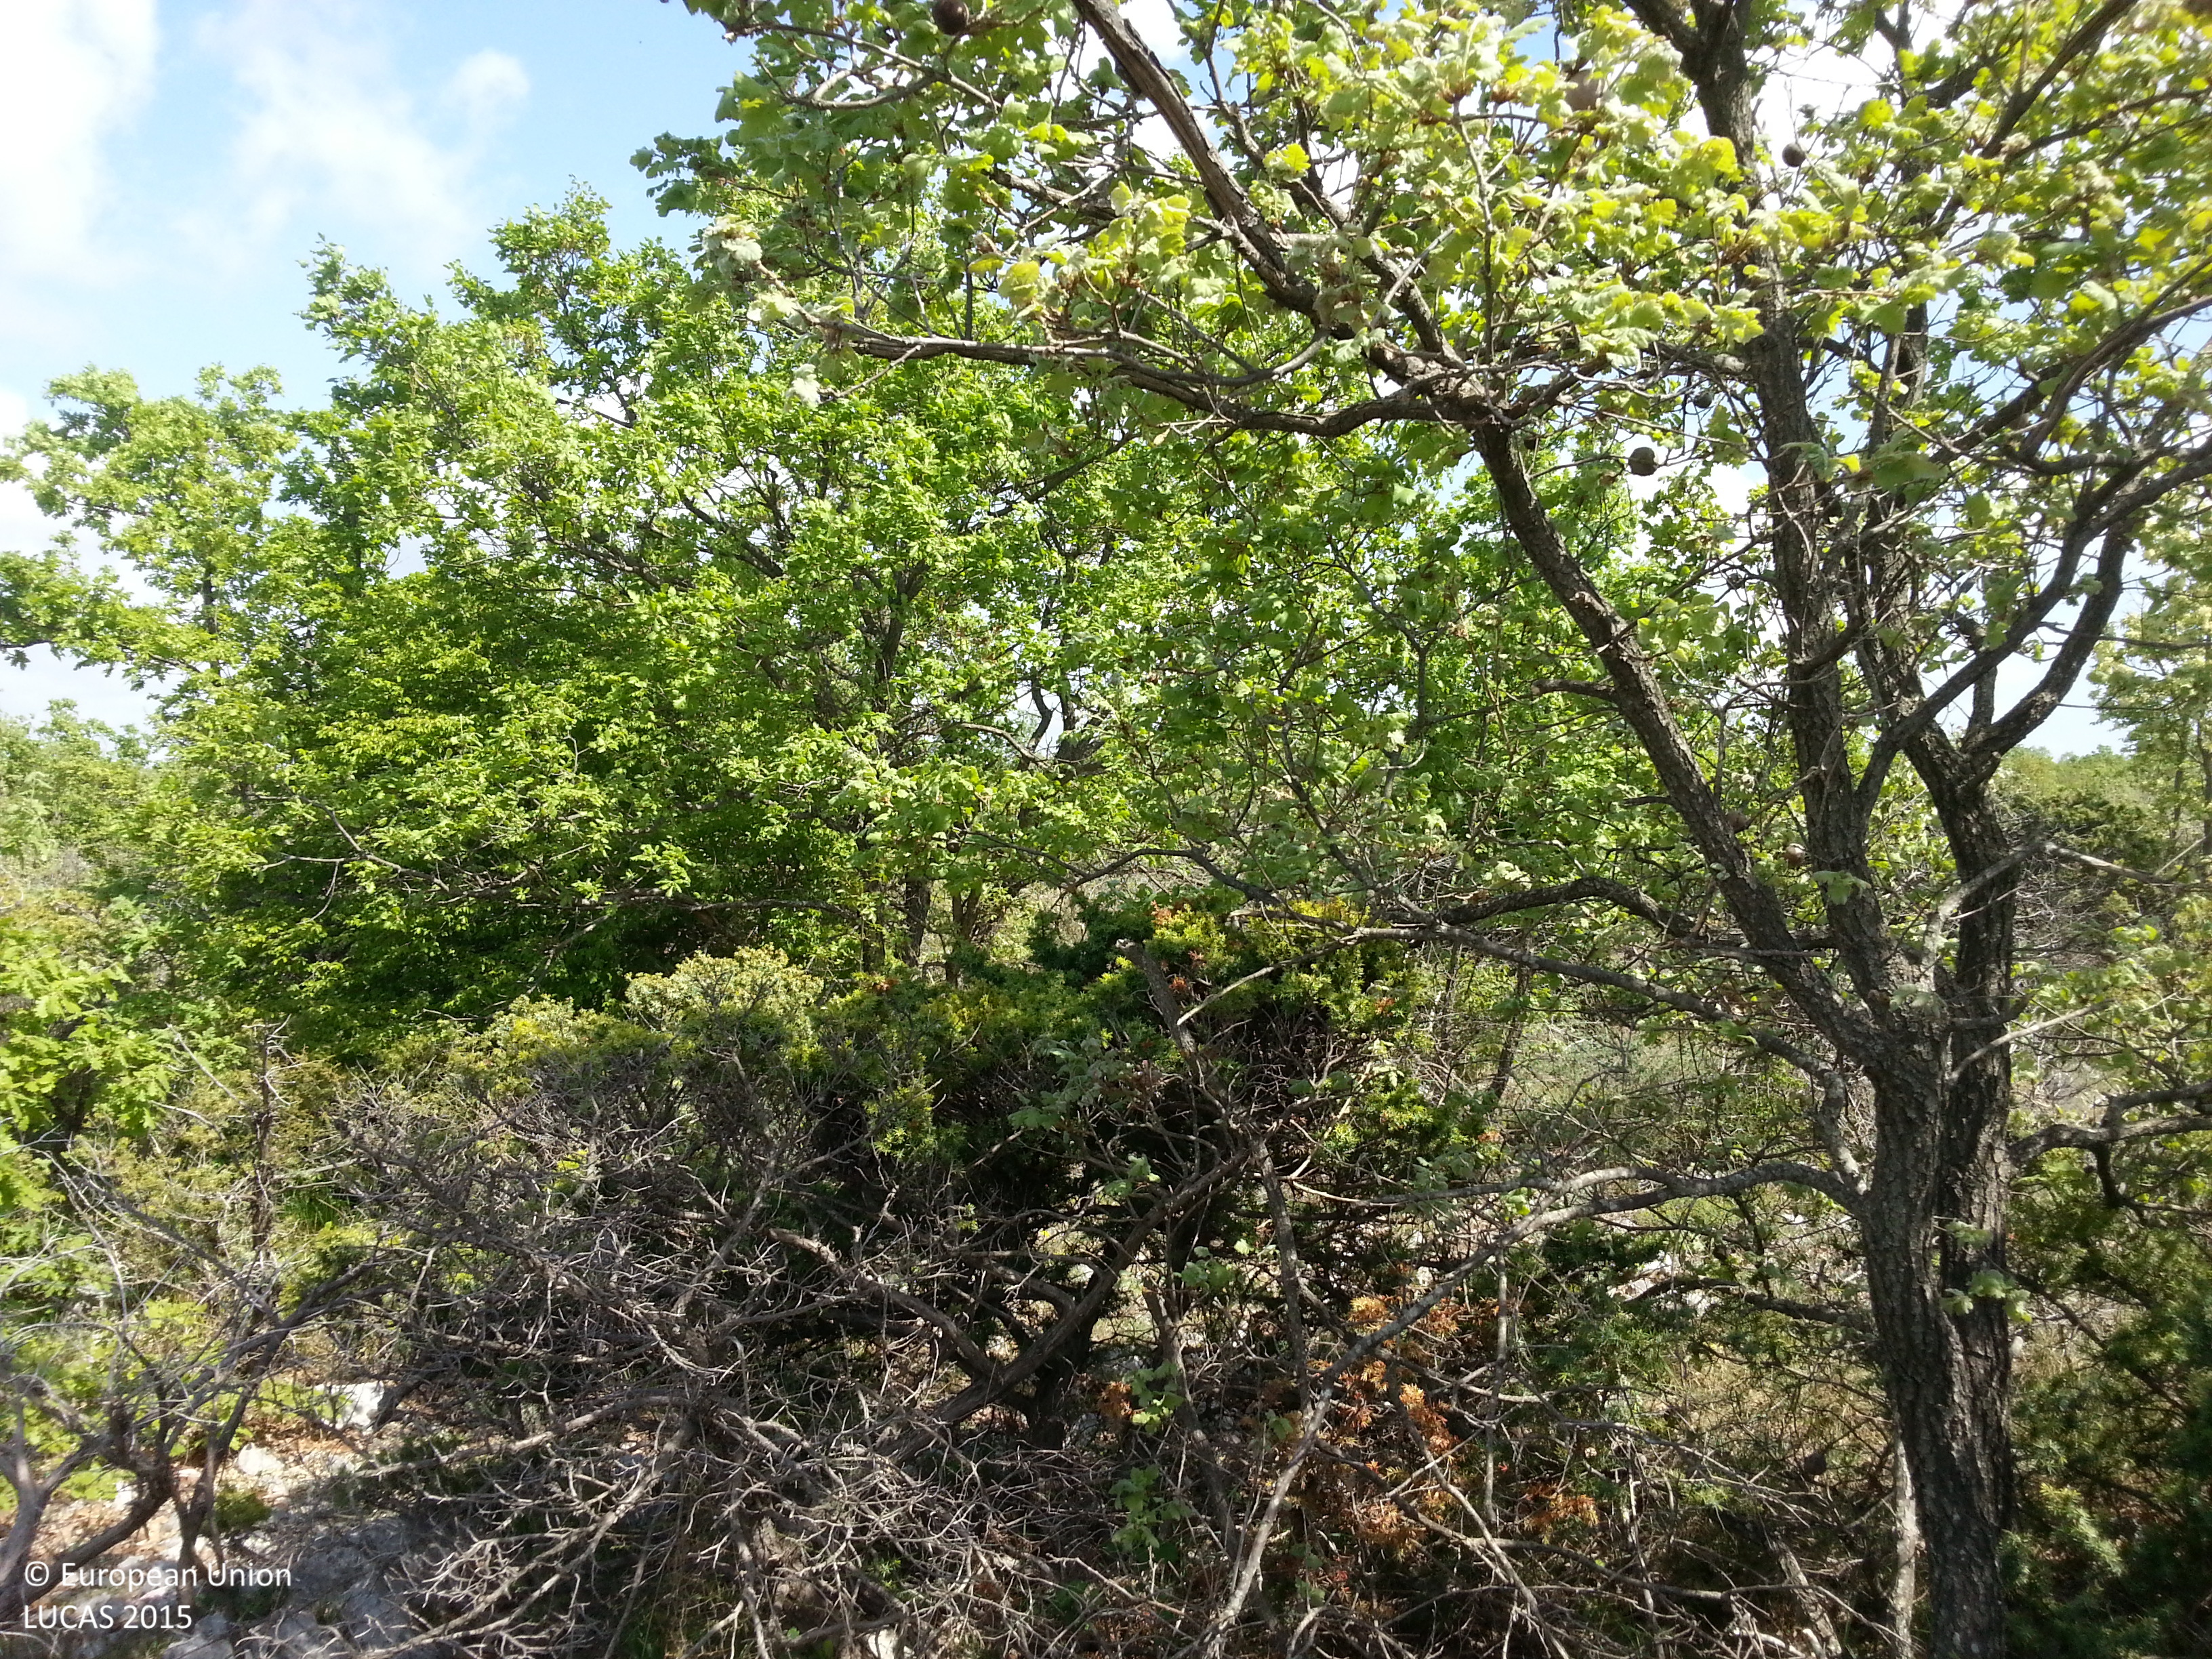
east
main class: Shrubland
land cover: Shrubland with sparse tree cover
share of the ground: > 75 %
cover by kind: shrubs 60 %, unconsolidated bare surface 20 %, herbaceous plants 15 %, coniferous forest trees 5 %
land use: Semi-natural and natural areas not in use
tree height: < 5 m
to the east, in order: Shrubland with sparse tree cover; Tracks; Shrubland with sparse tree cover
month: April
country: HR
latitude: 44.0203
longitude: 15.5682
